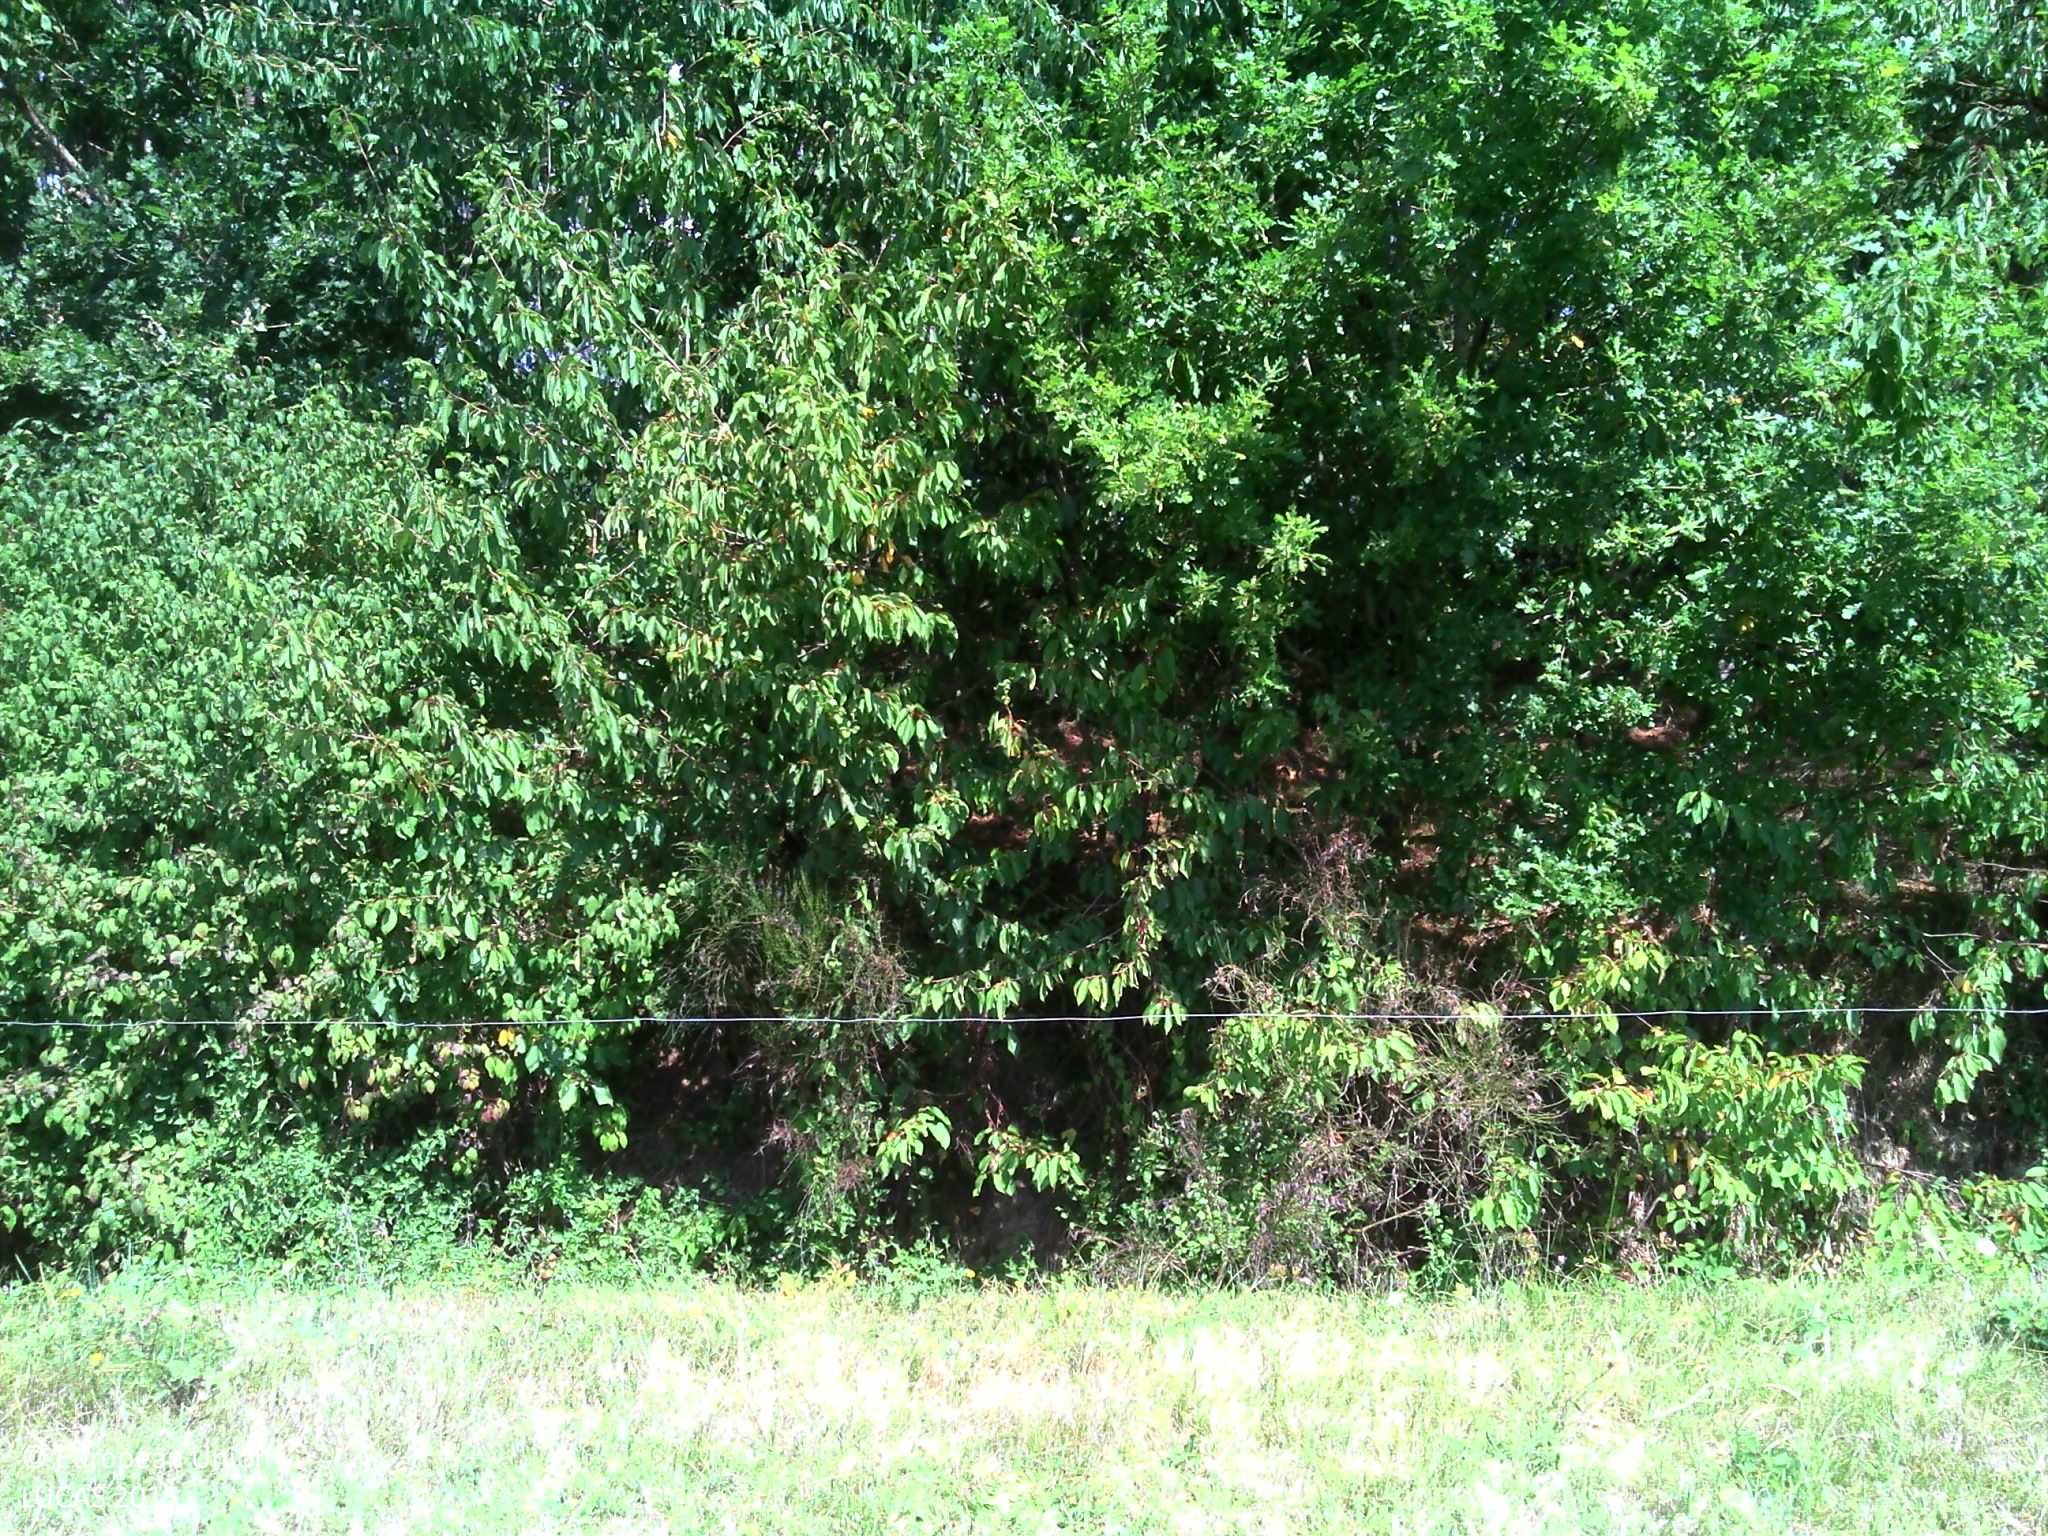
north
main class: Grassland
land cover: Grassland without tree/shrub cover
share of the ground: > 75 %
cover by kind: herbaceous plants 100 %
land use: Agriculture (excluding fallow land and kitchen gardens)
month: August
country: FR
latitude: 47.9272
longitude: -1.1625
